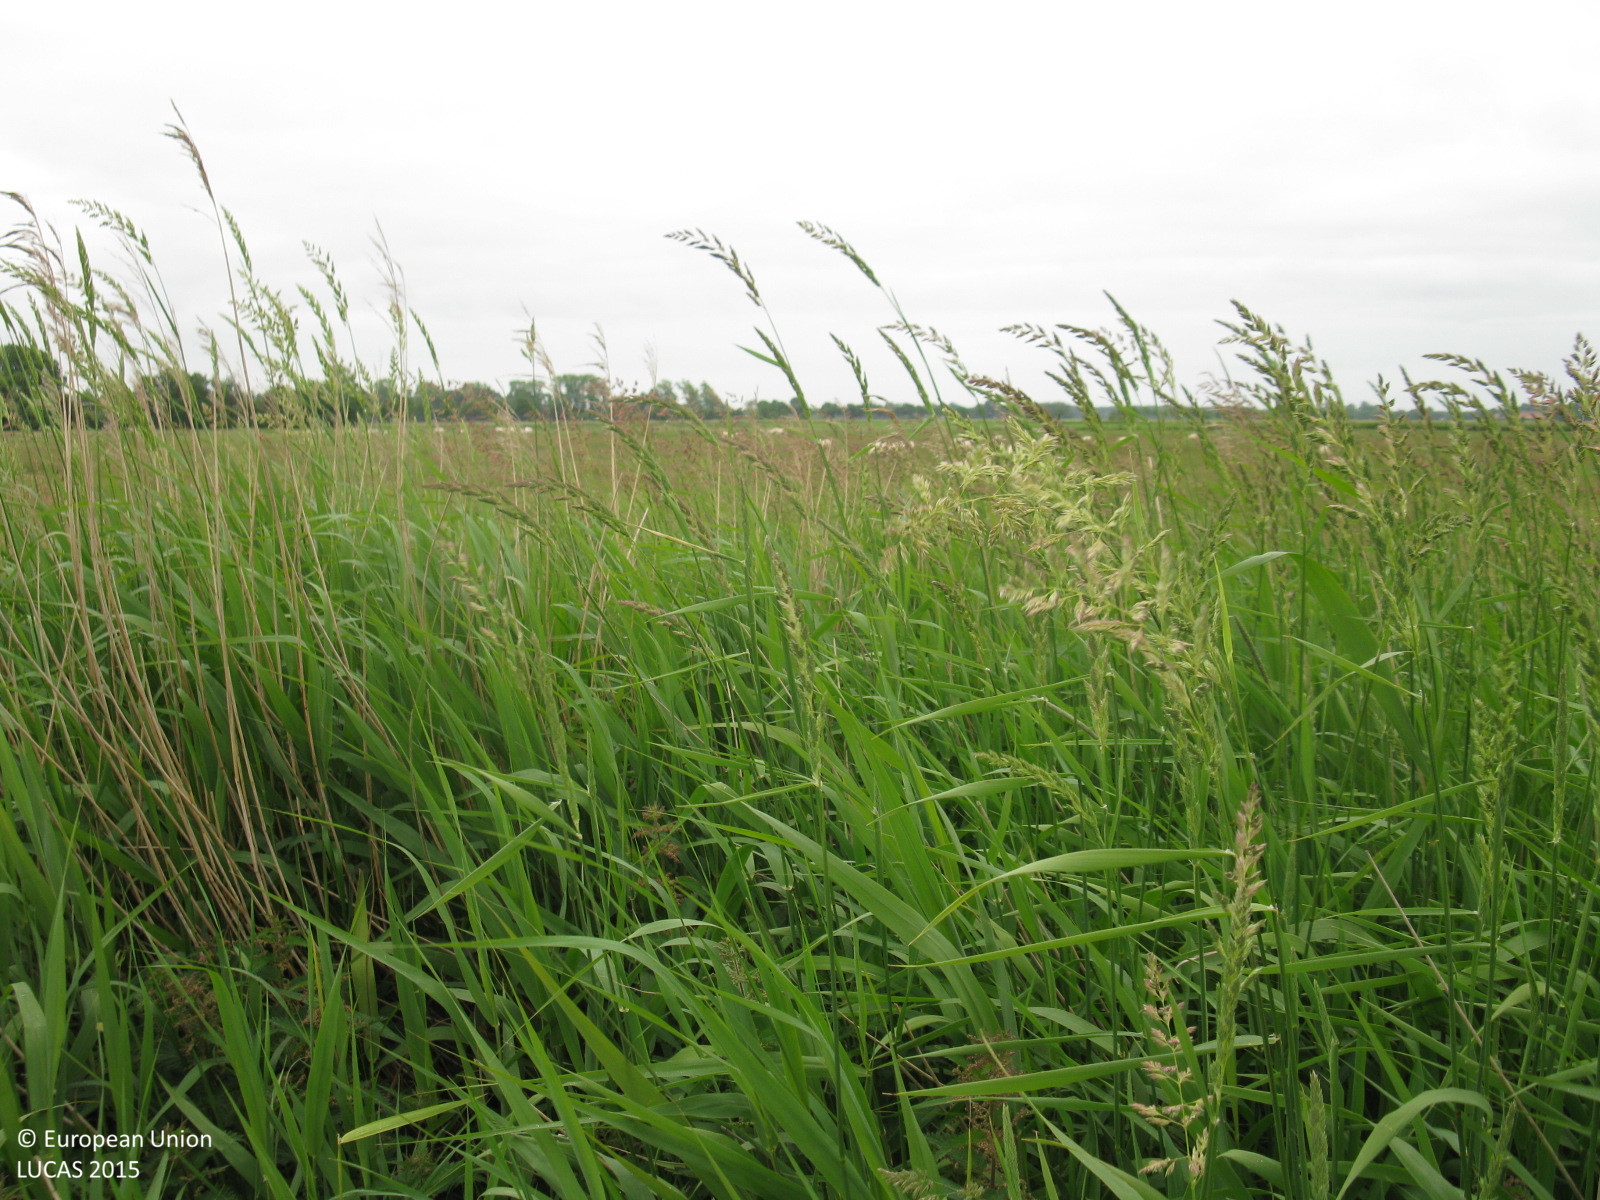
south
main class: Grassland
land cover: Grassland without tree/shrub cover
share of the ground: > 75 %
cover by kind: herbaceous plants 100 %
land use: Agriculture (excluding fallow land and kitchen gardens)
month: June
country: DE
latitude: 53.6005
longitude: 7.9607
